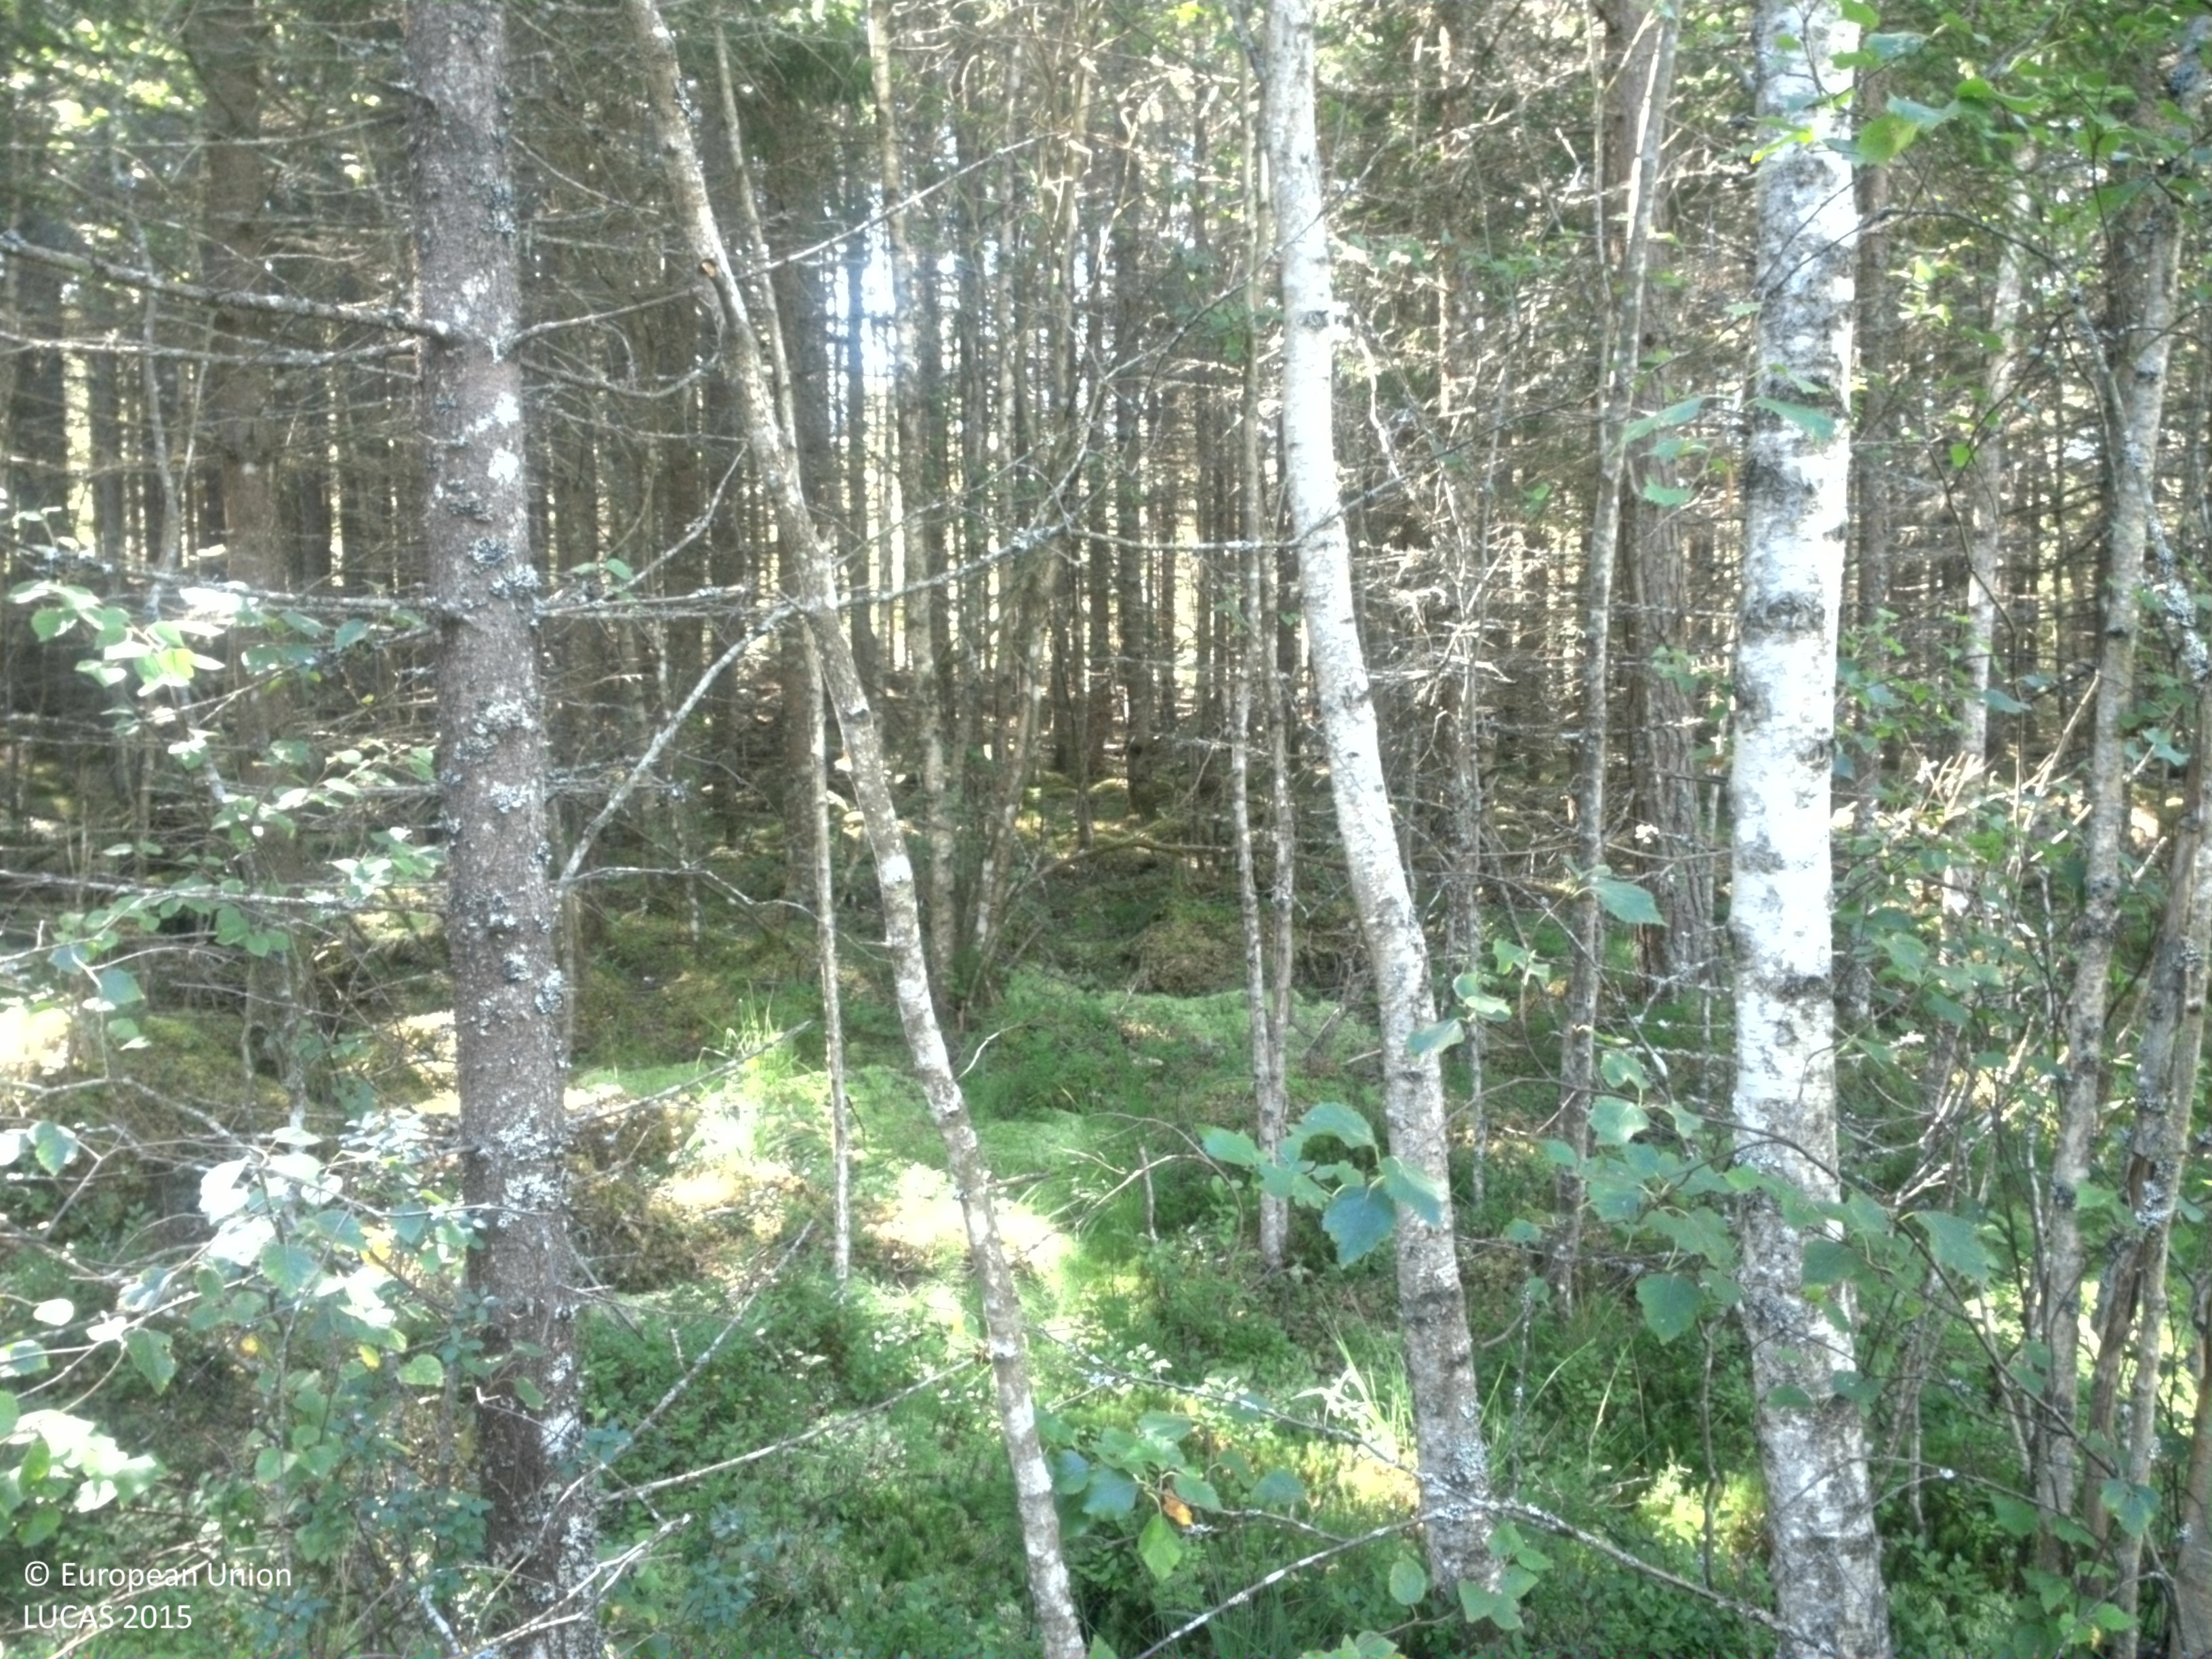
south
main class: Woodland
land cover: Spruce dominated mixed woodland
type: boreal forest
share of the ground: 50 - 75 %
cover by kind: coniferous forest trees 25 %, broadleaved forest trees 25 %, herbaceous plants 25 %, lichens and mosses 25 %
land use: Forestry
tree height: > 5 m
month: August
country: SE
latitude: 58.1249
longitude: 13.3055
